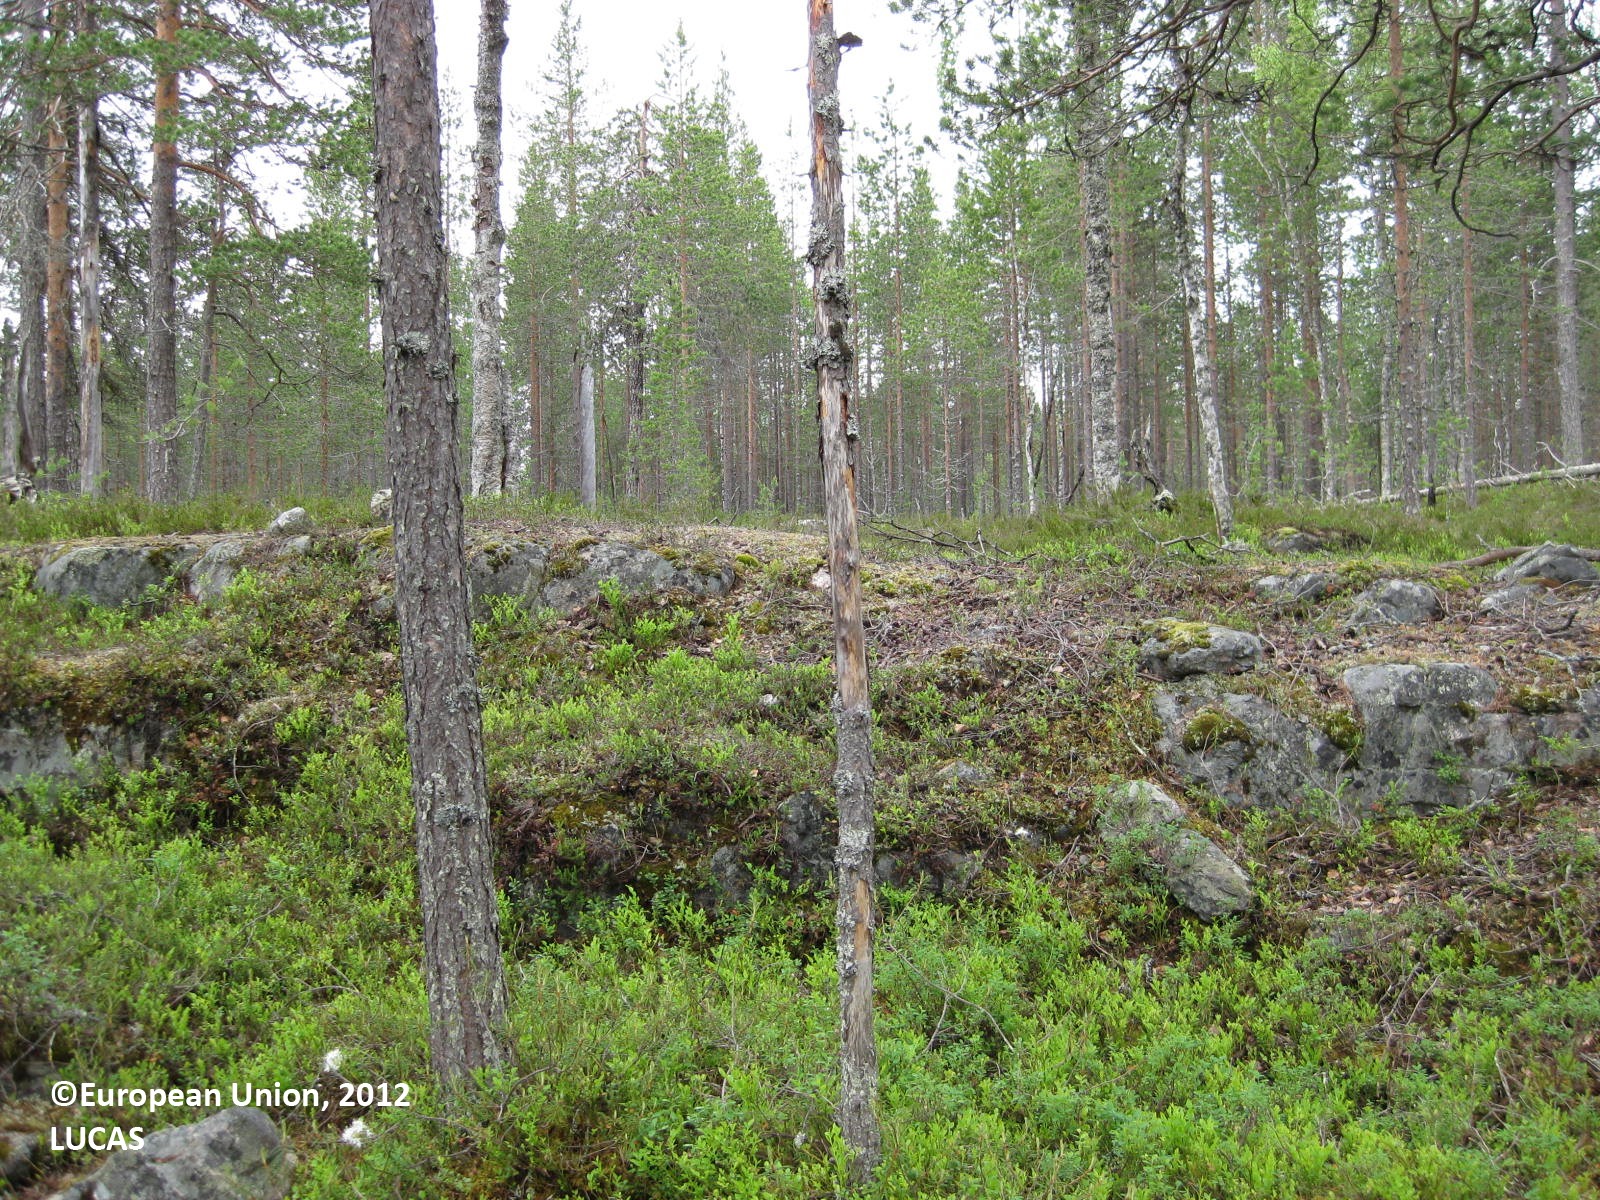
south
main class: Woodland
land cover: Pine dominated coniferous woodland
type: boreal forest
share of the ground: 50 - 75 %
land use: Forestry
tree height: > 5 m
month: June
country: FI
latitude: 65.1060
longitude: 29.2945
